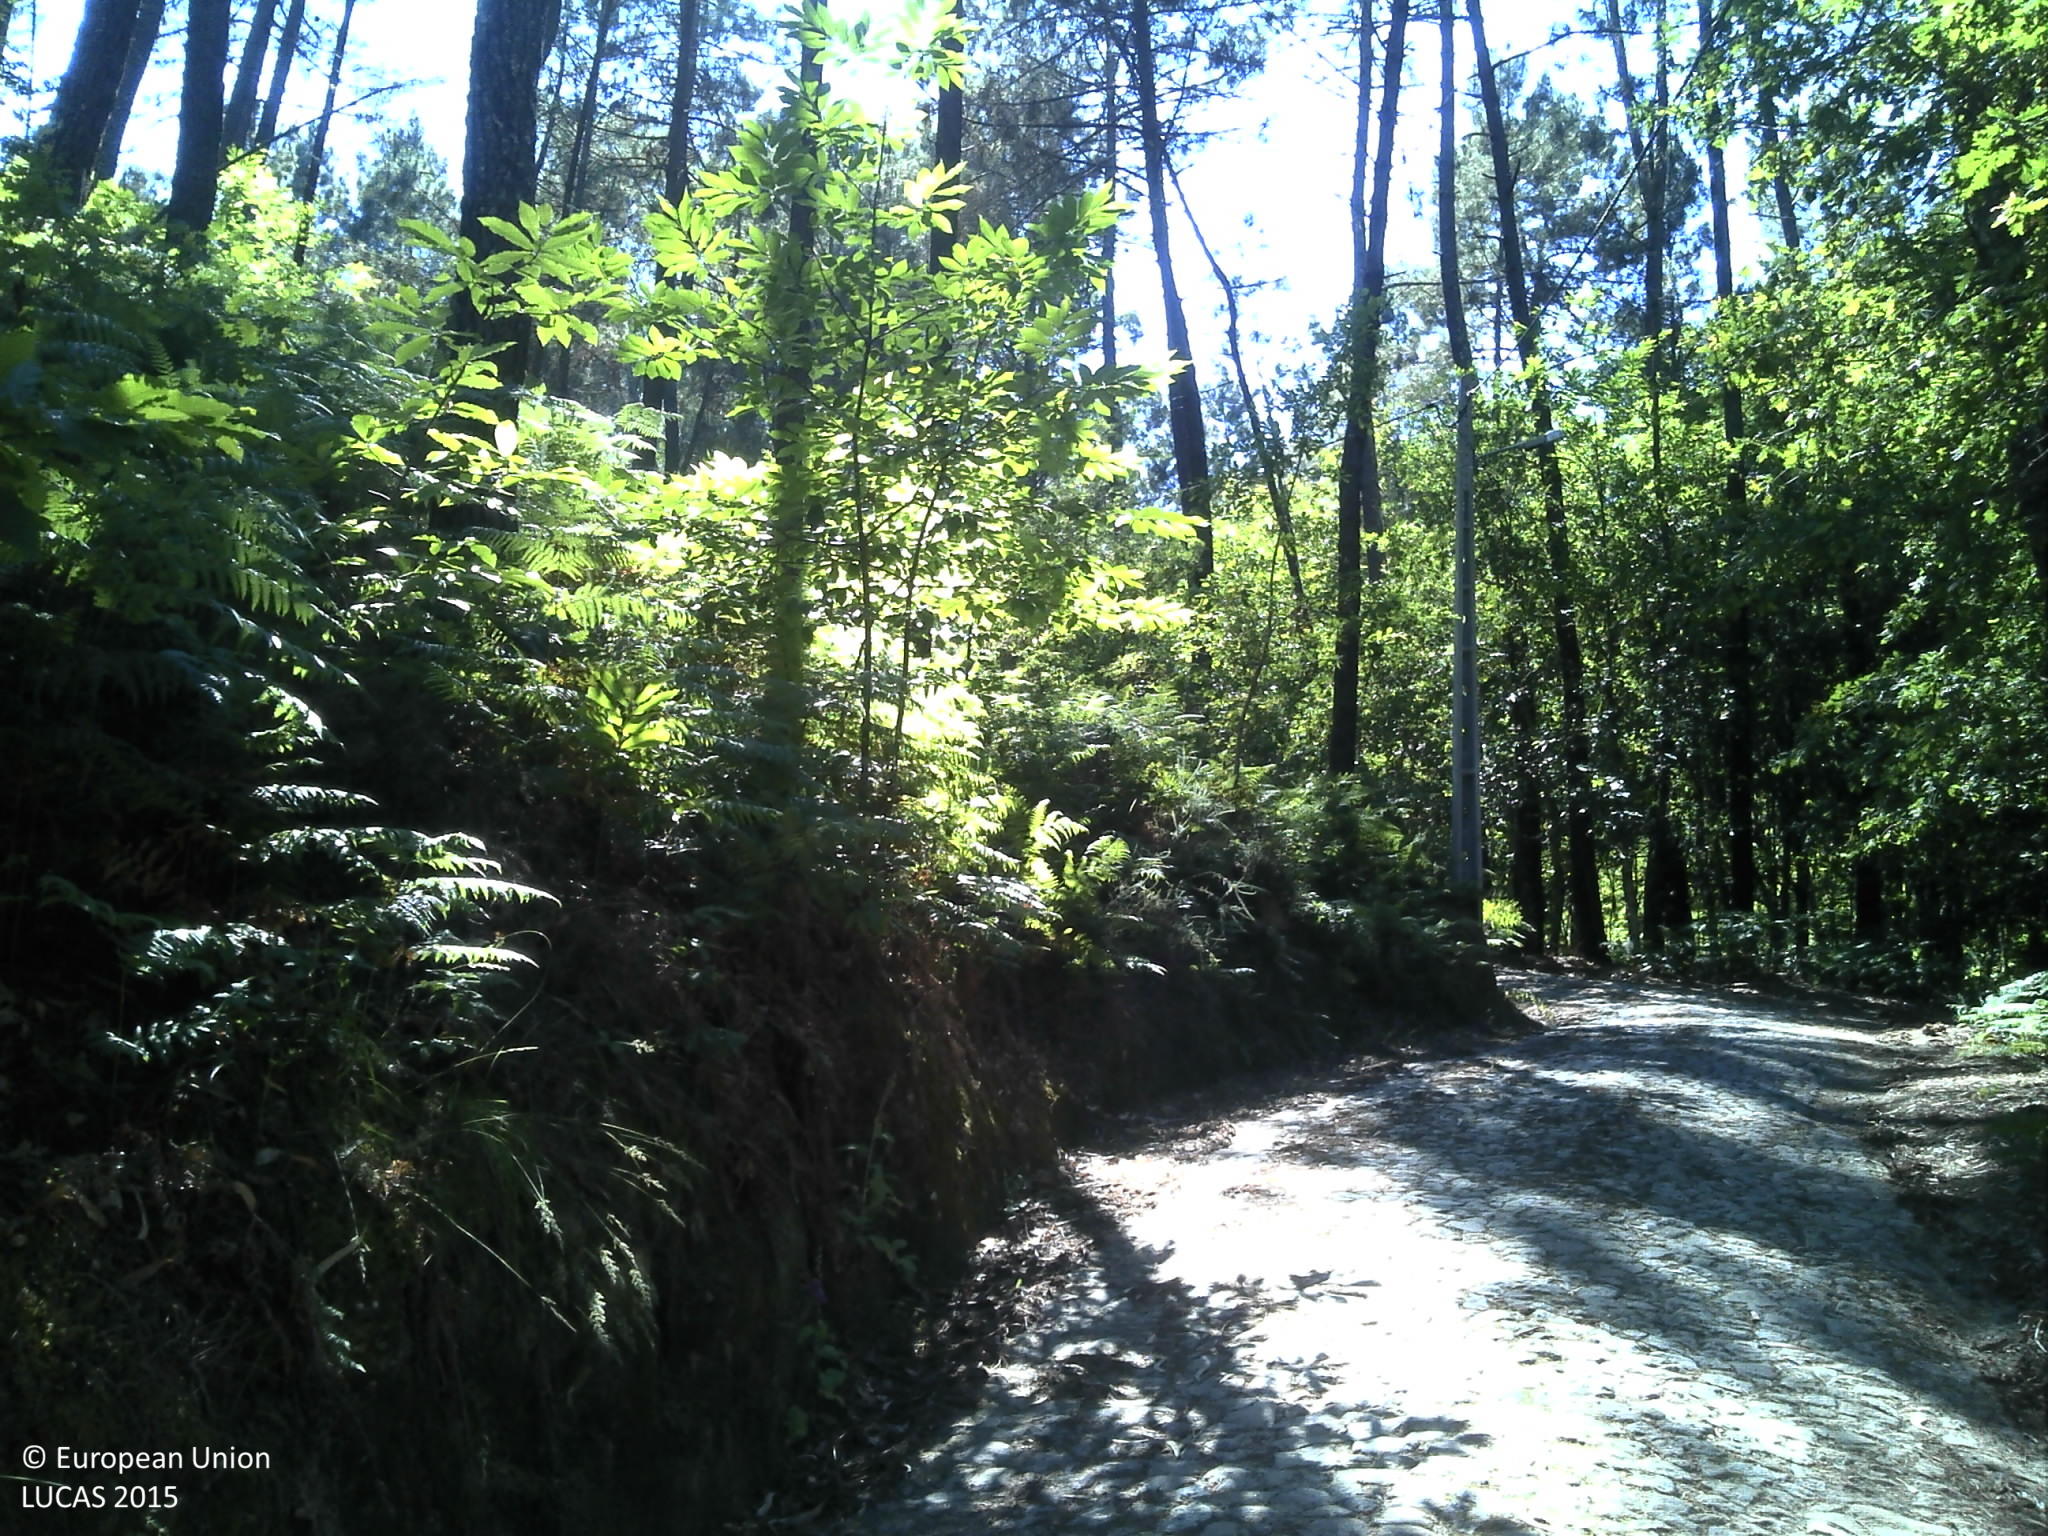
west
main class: Woodland
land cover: Pine dominated mixed woodland
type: coniferous forest of the mediterranean region
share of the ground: 50 - 75 %
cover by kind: coniferous forest trees 50 %, broadleaved forest trees 25 %, shrubs 10 %, herbaceous plants 10 %, unconsolidated bare surface 5 %
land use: Forestry
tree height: > 5 m
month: June
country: PT
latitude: 40.7400
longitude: -8.0465
